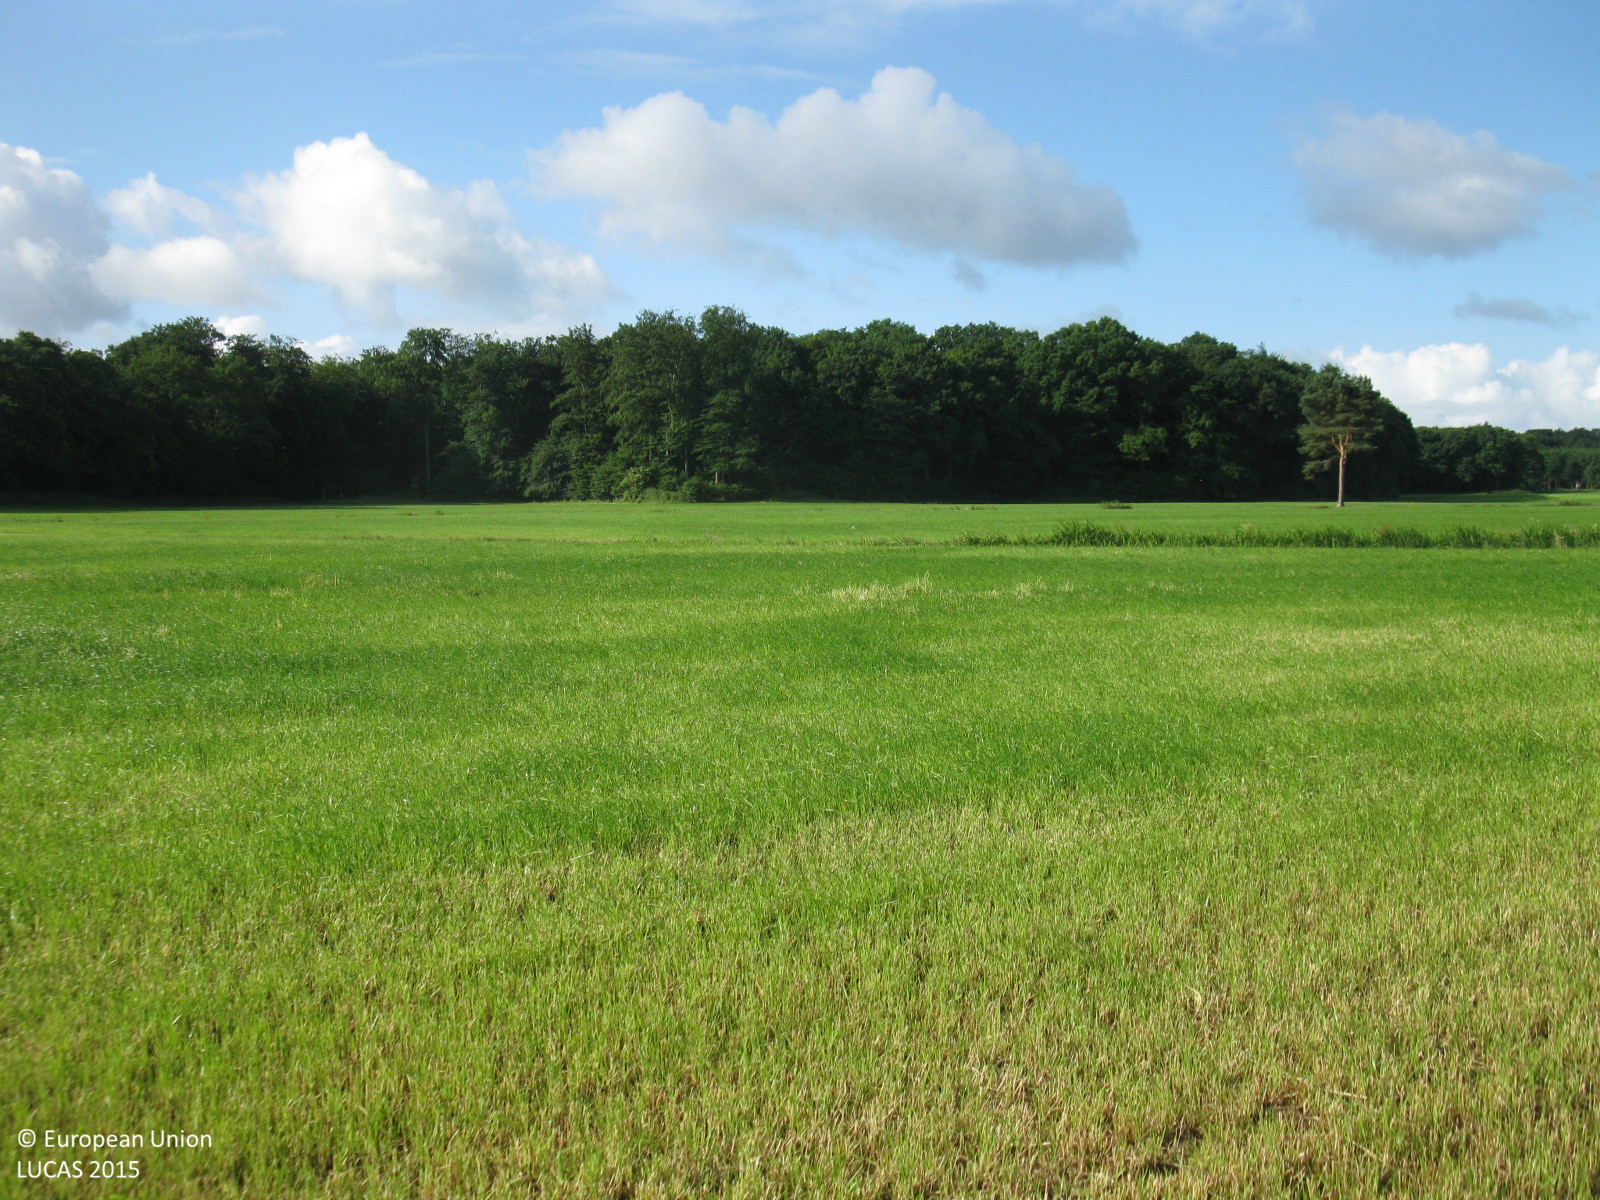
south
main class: Grassland
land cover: Grassland without tree/shrub cover
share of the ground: > 75 %
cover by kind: herbaceous plants 100 %
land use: Agriculture (excluding fallow land and kitchen gardens)
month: July
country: DE
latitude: 53.4029
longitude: 7.9701
